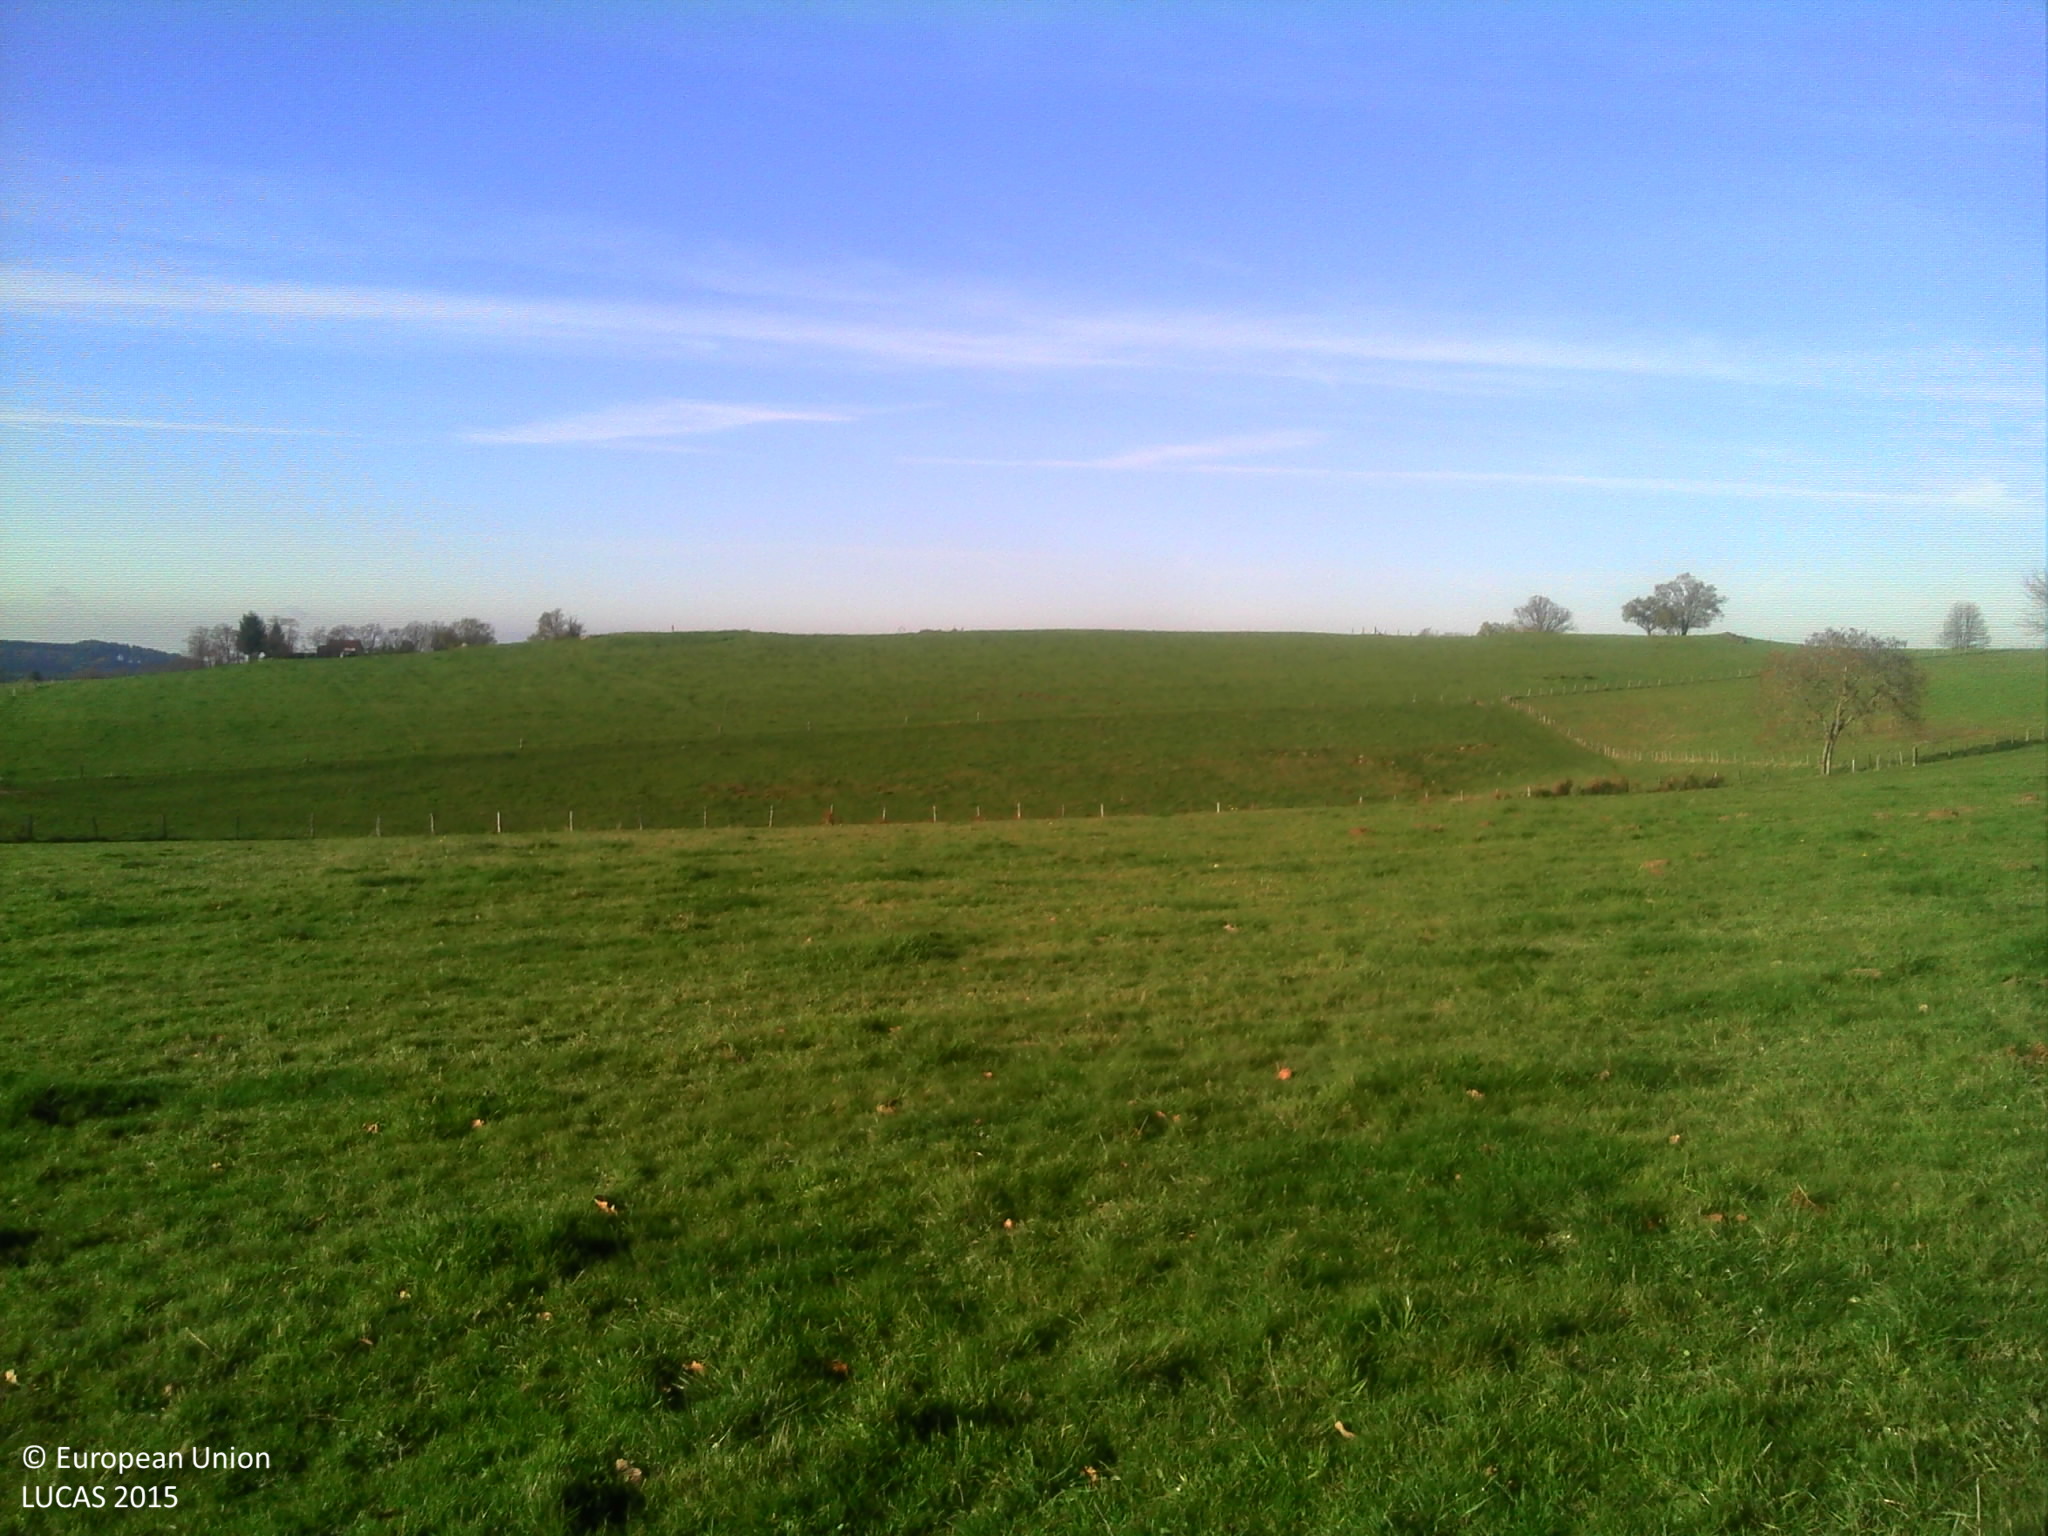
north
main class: Grassland
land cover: Grassland without tree/shrub cover
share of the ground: > 75 %
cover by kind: herbaceous plants 100 %
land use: Agriculture (excluding fallow land and kitchen gardens)
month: November
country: FR
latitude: 46.1292
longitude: 3.6974
